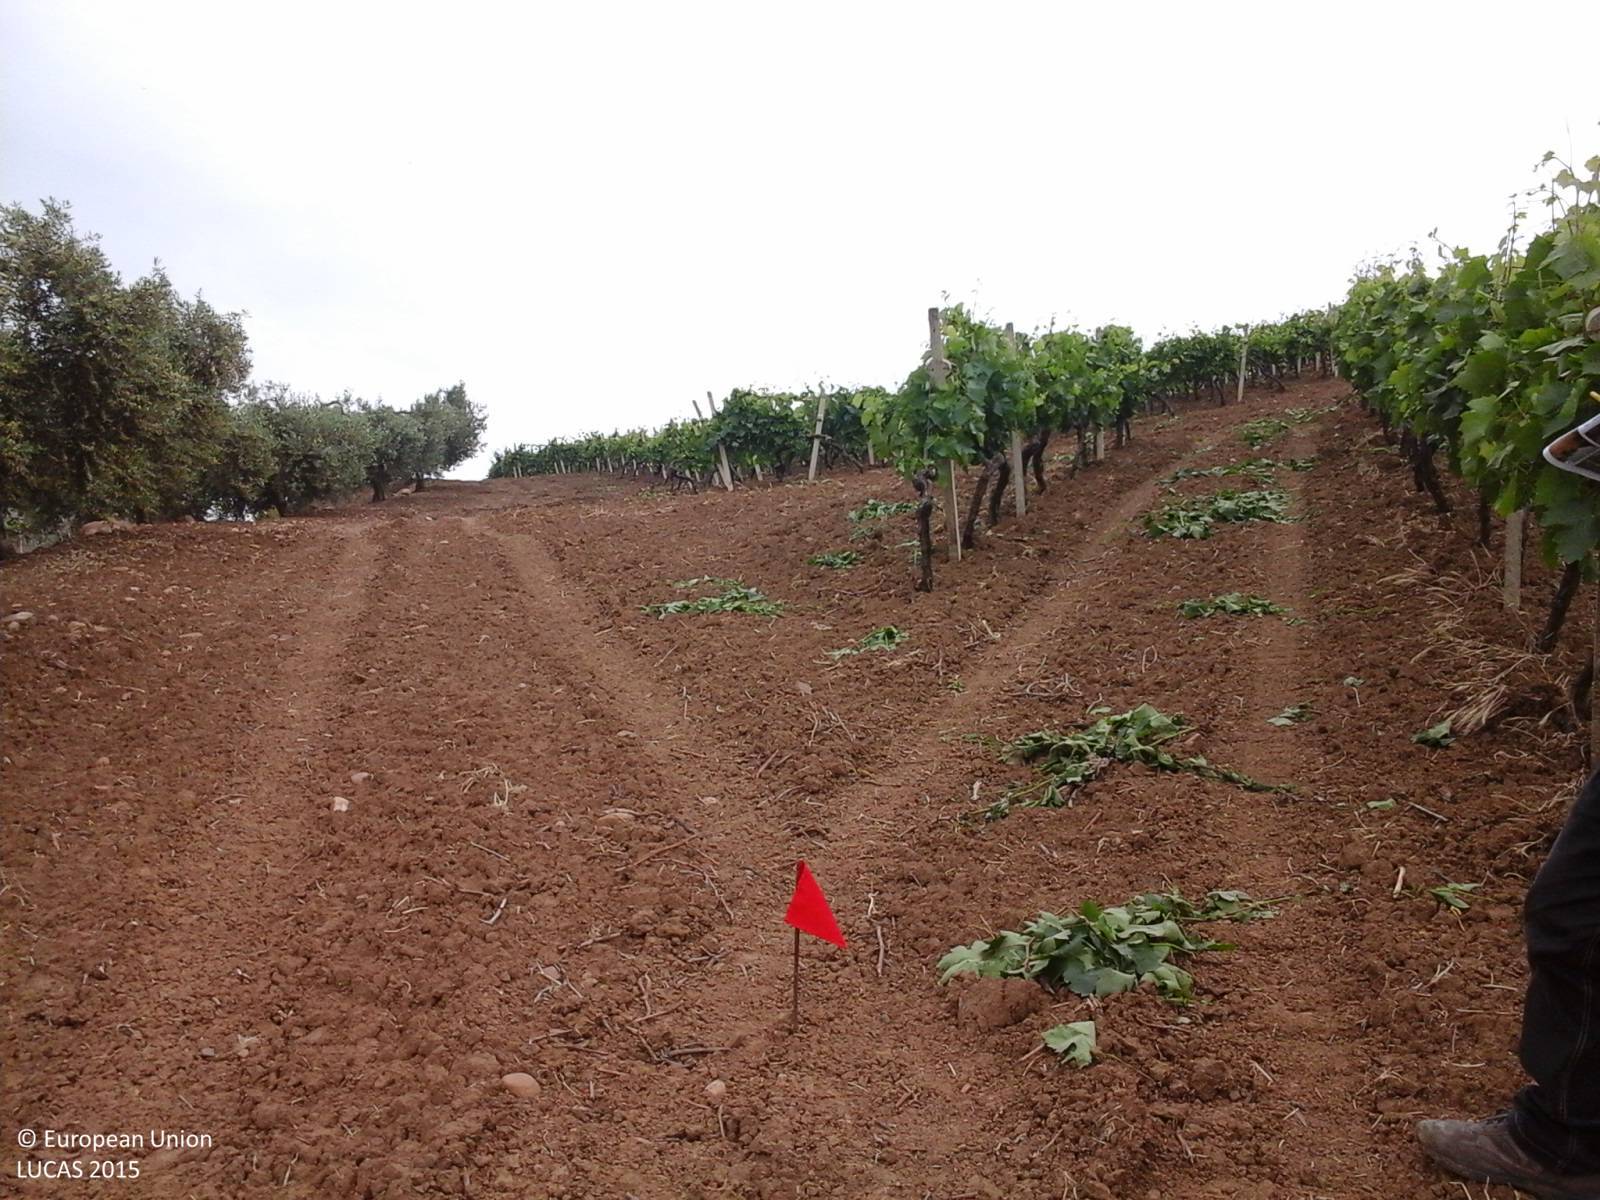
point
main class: Cropland
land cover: Vineyards
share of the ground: 50 - 75 %
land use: Agriculture (excluding fallow land and kitchen gardens)
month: June
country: IT
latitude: 37.9118
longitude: 13.1958
